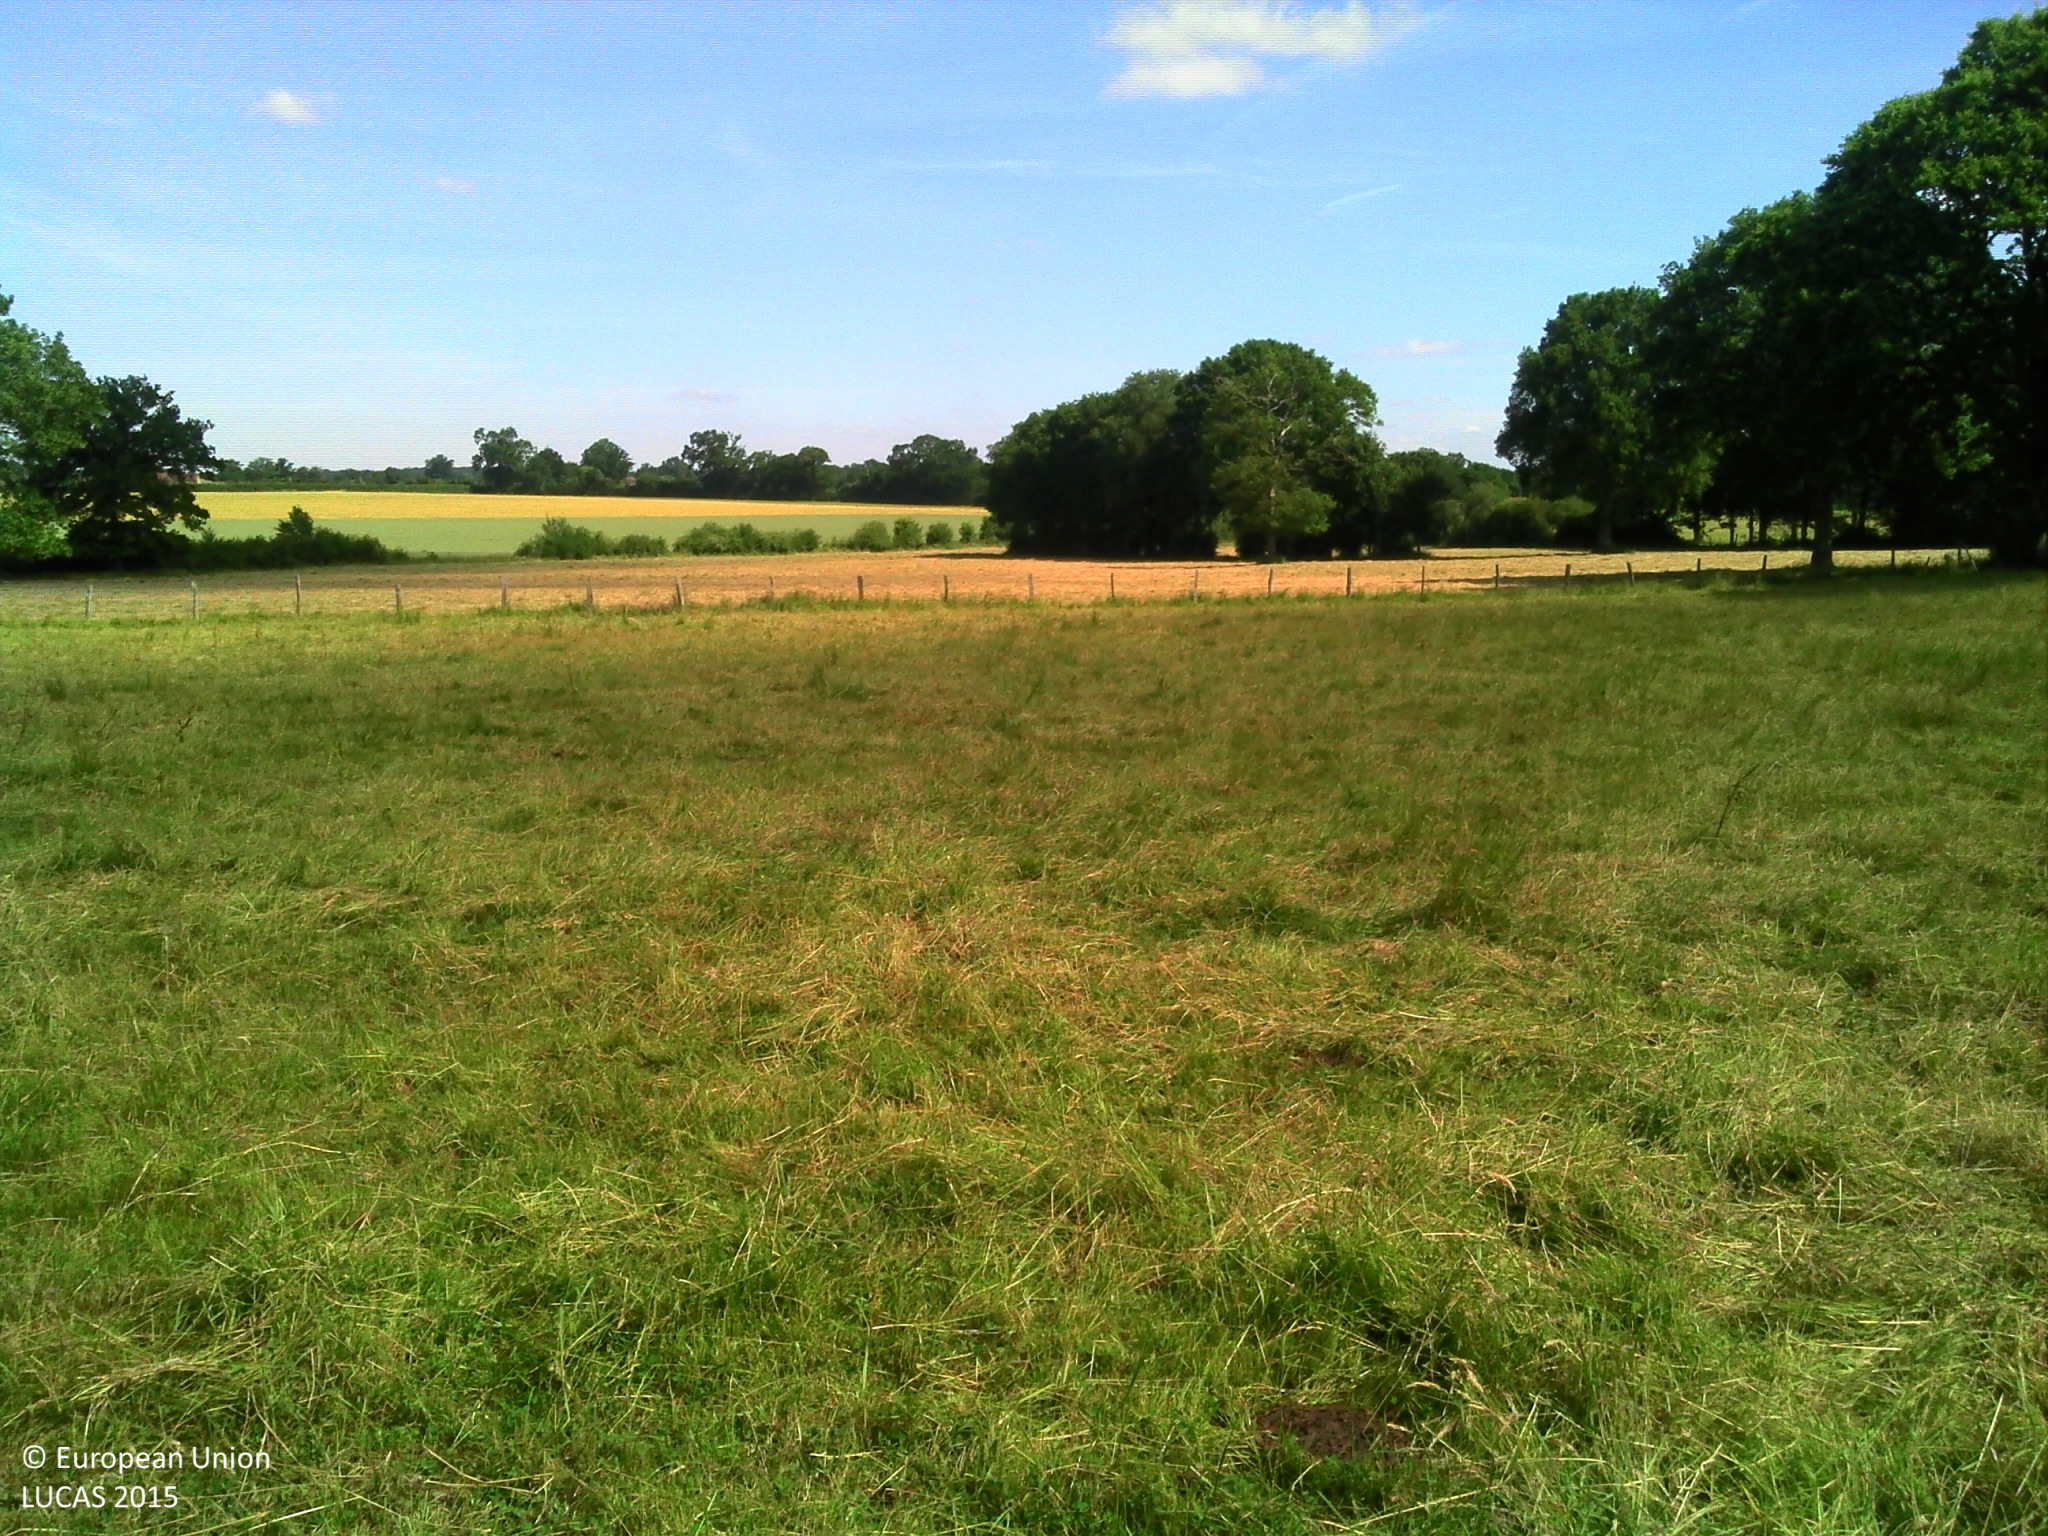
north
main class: Grassland
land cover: Grassland without tree/shrub cover
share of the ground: > 75 %
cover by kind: herbaceous plants 100 %
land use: Agriculture (excluding fallow land and kitchen gardens)
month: June
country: FR
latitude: 48.6277
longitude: -0.1119
